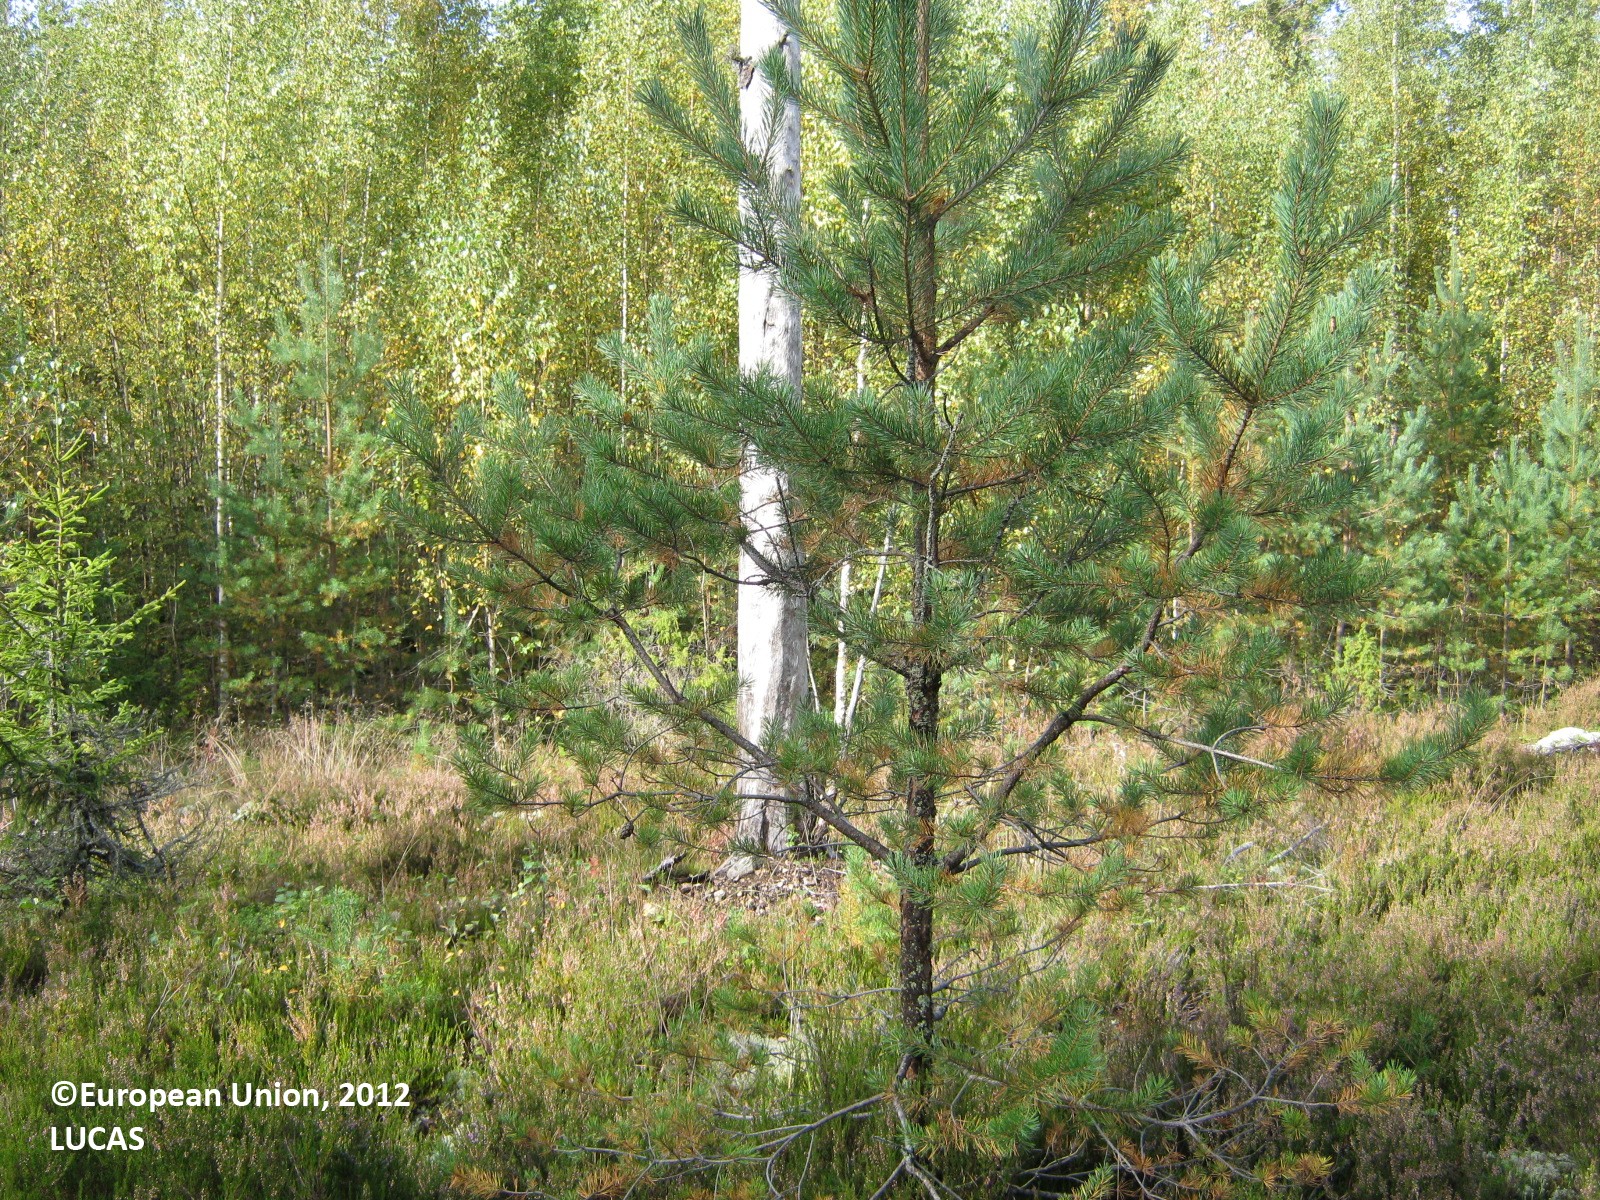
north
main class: Woodland
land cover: Pine dominated mixed woodland
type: boreal forest
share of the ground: > 75 %
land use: Forestry
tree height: > 5 m
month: September
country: FI
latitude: 60.6191
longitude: 27.8674
